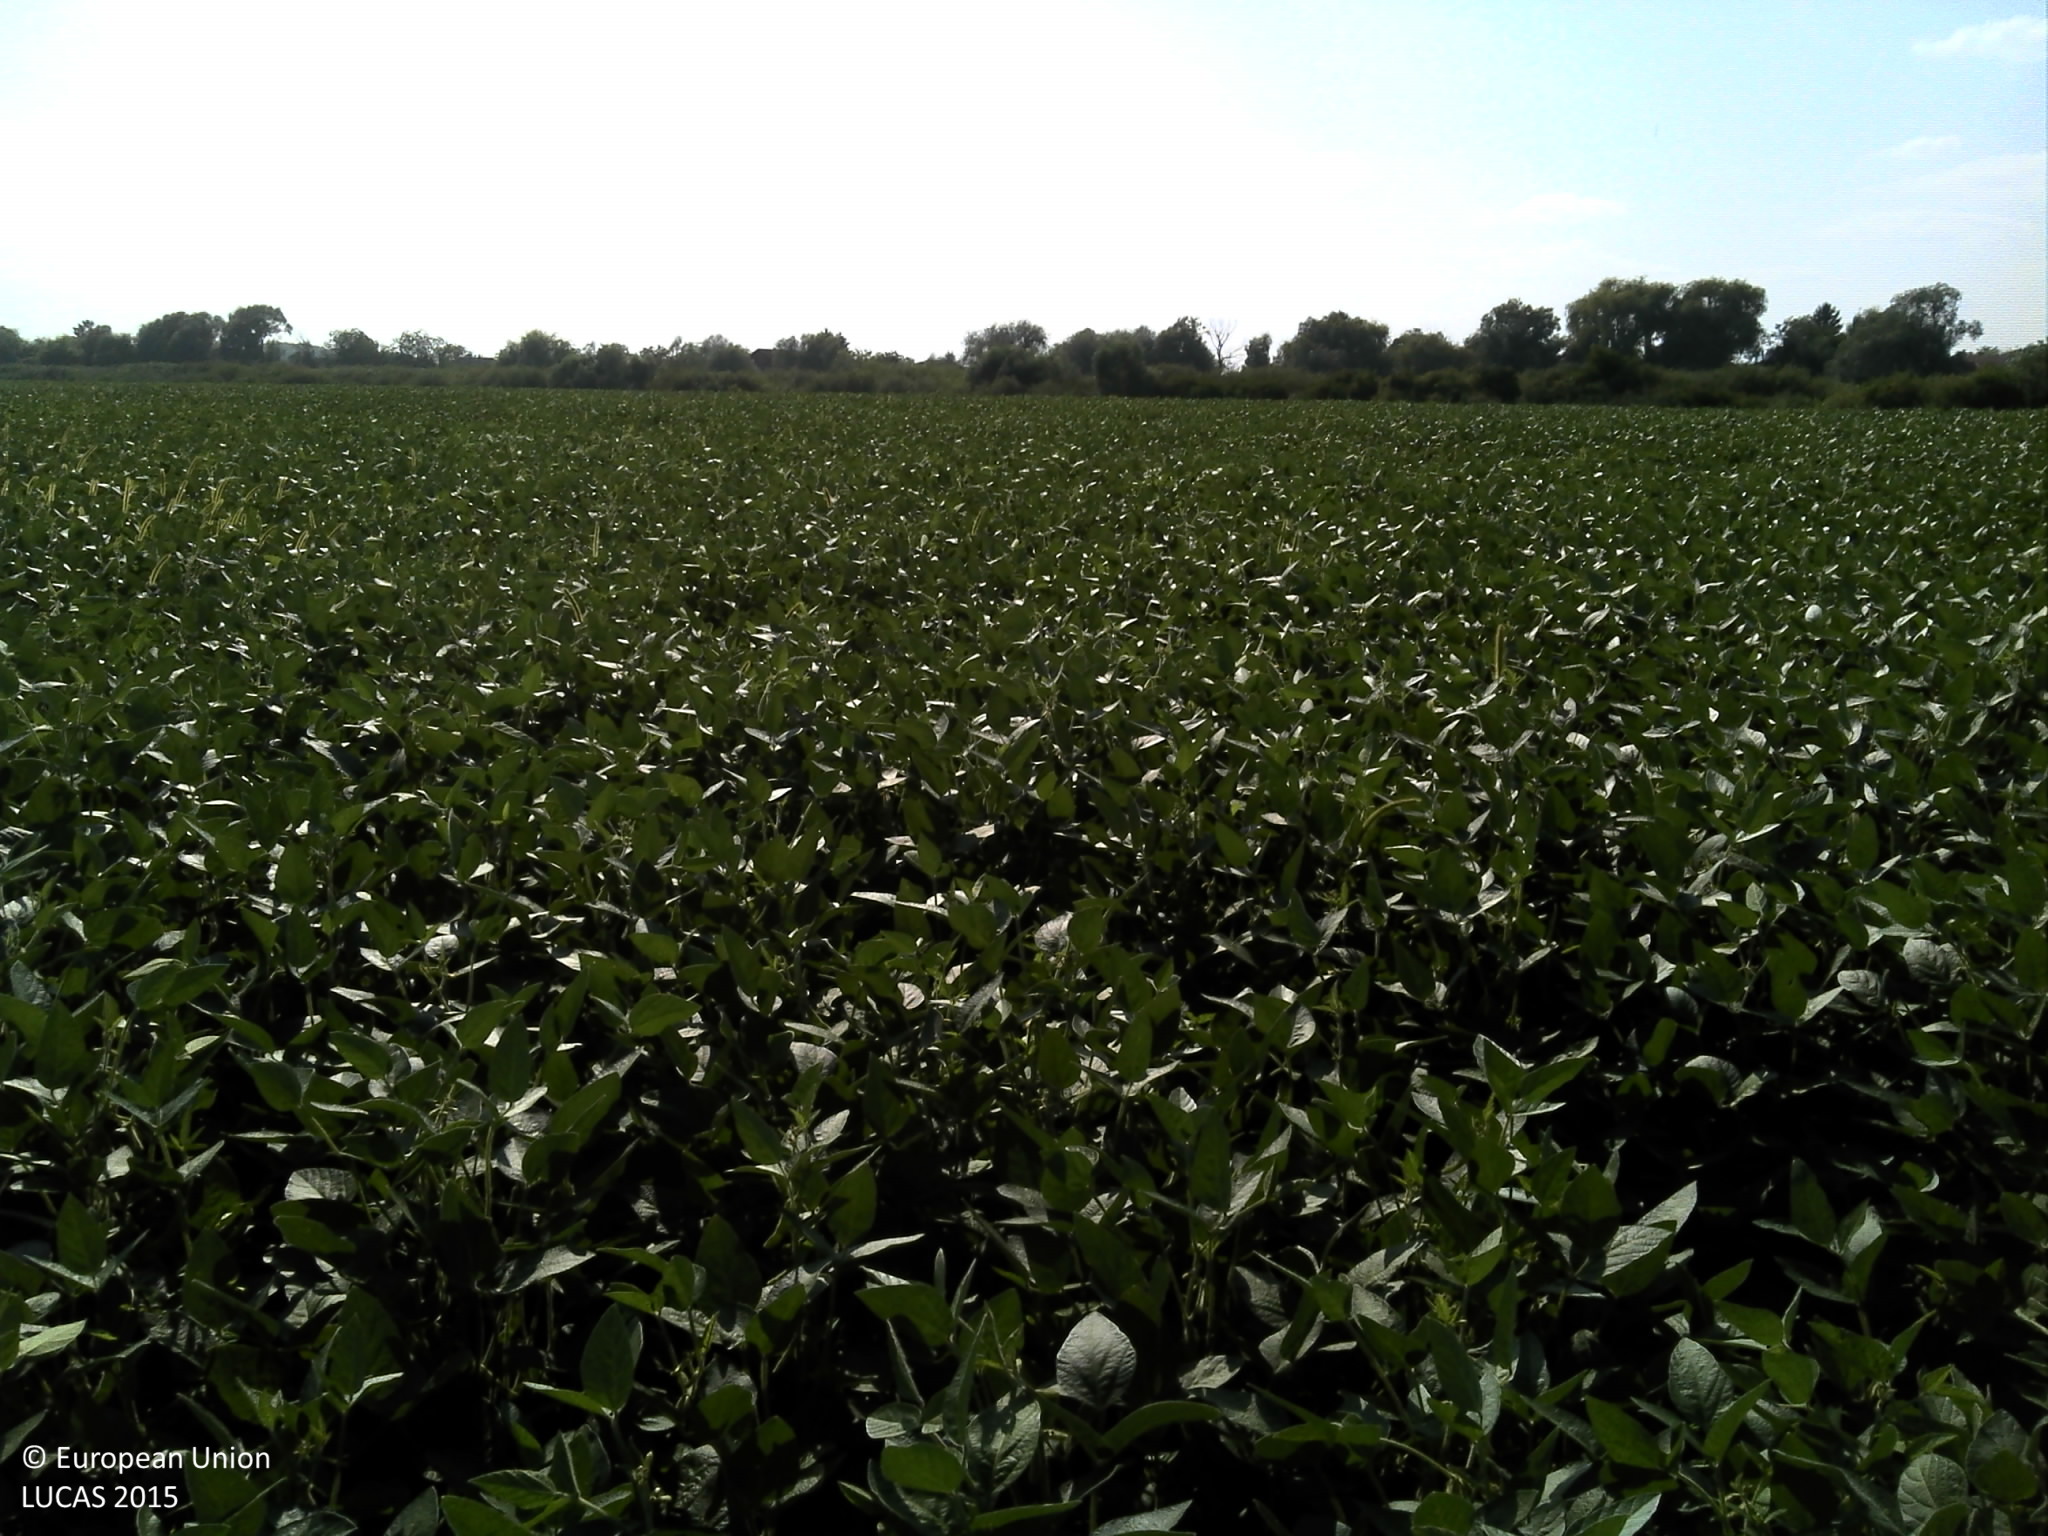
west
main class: Cropland
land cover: Soya
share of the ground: > 75 %
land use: Agriculture (excluding fallow land and kitchen gardens)
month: August
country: HR
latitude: 45.4709
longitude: 16.4318
